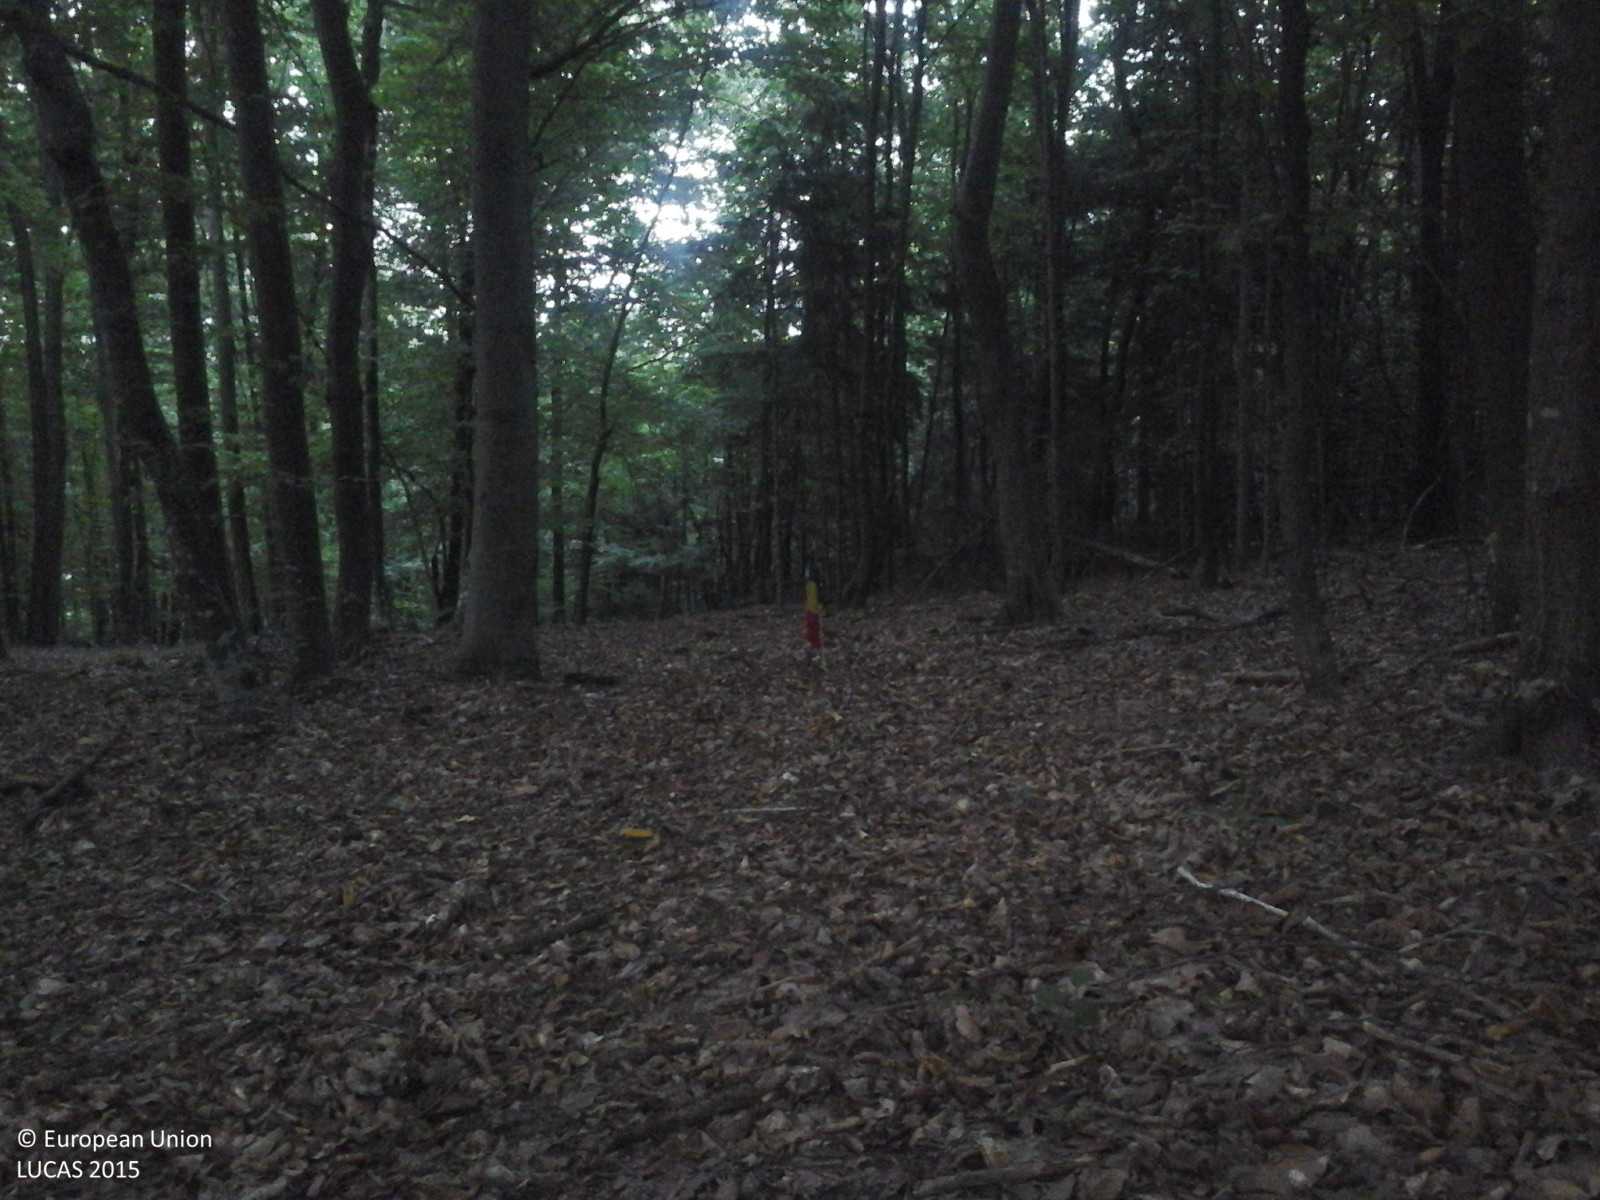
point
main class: Woodland
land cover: Broadleaved woodland
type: beech forest
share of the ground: > 75 %
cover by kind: broadleaved forest trees 100 %
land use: Forestry
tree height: > 5 m
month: September
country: RO
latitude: 47.1159
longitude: 22.5901
